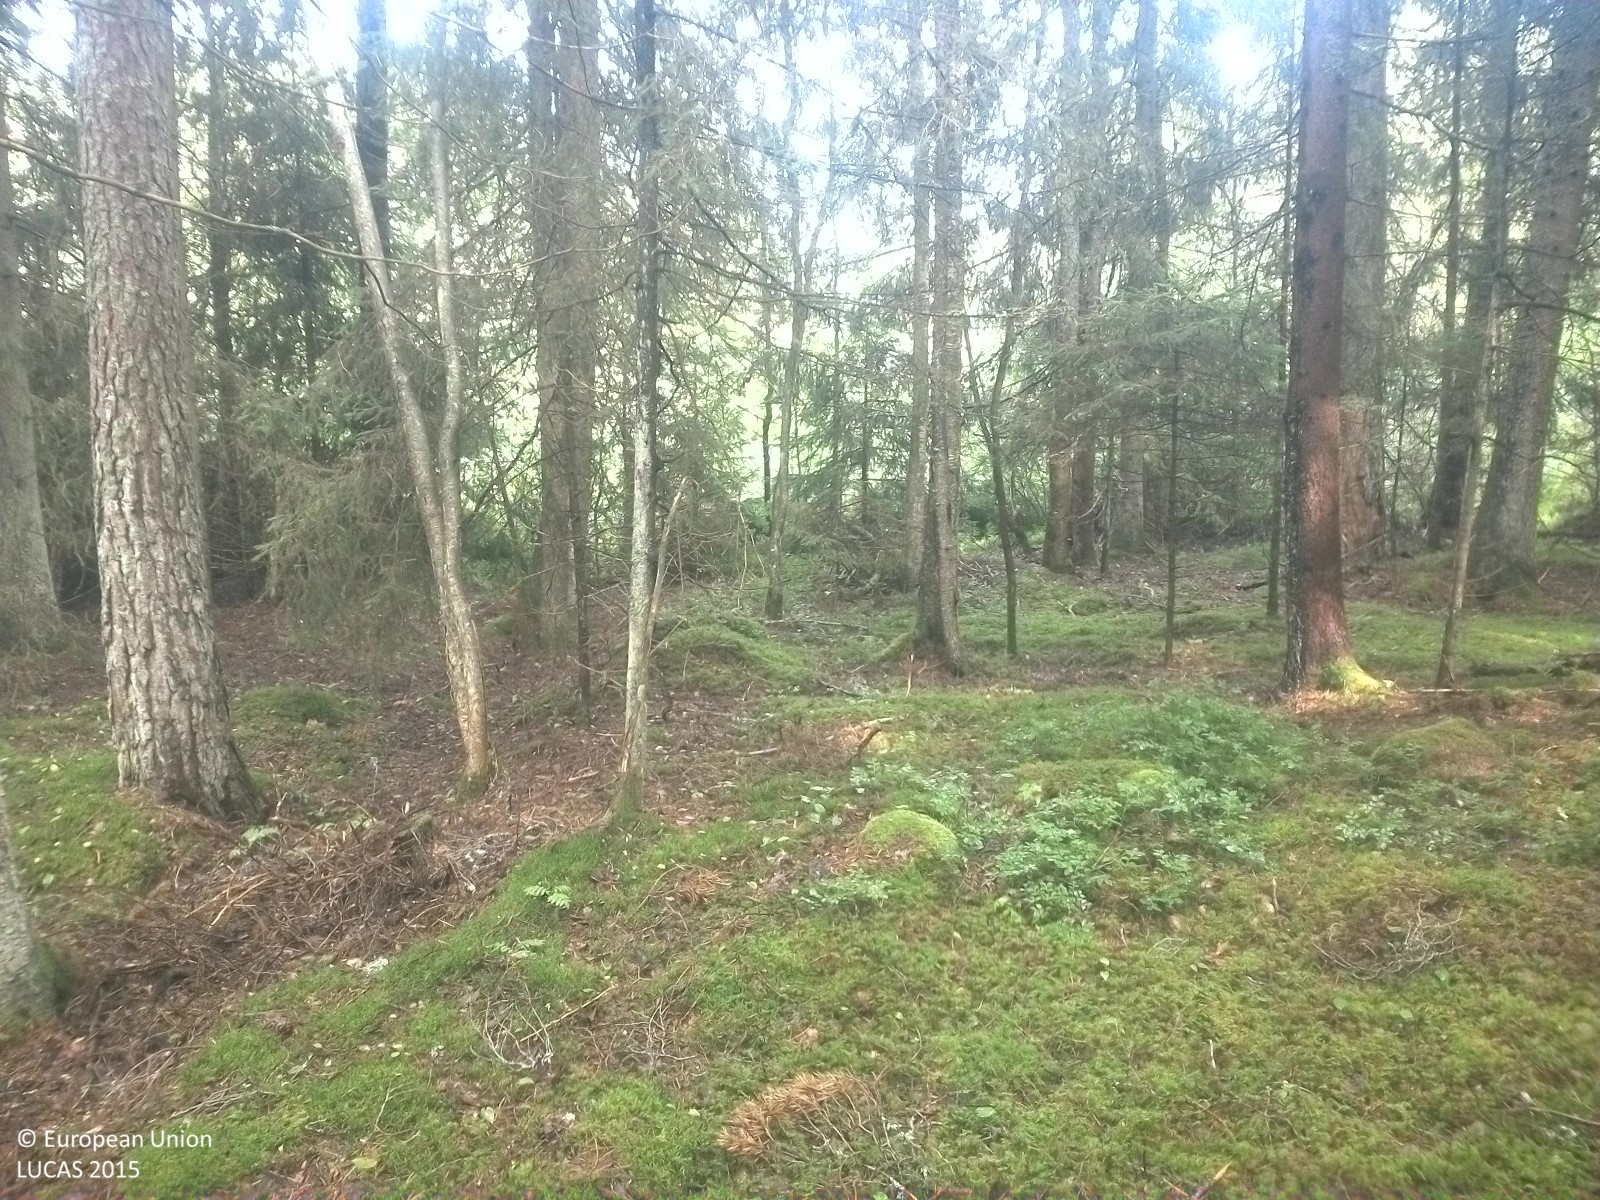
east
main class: Woodland
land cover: Other coniferous woodland
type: boreal forest
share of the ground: 25 - 50 %
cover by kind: lichens and mosses 45 %, coniferous forest trees 40 %, herbaceous plants 15 %
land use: Forestry
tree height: > 5 m
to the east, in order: Other coniferous woodland; Other mixed woodland; Broadleaved woodland; Dry stone walls; Broadleaved woodland; Ditches and canals; Broadleaved woodland; Dry stone walls; Pine dominated mixed woodland; Pine dominated coniferous woodland
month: August
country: SE
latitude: 59.1346
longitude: 15.0425
